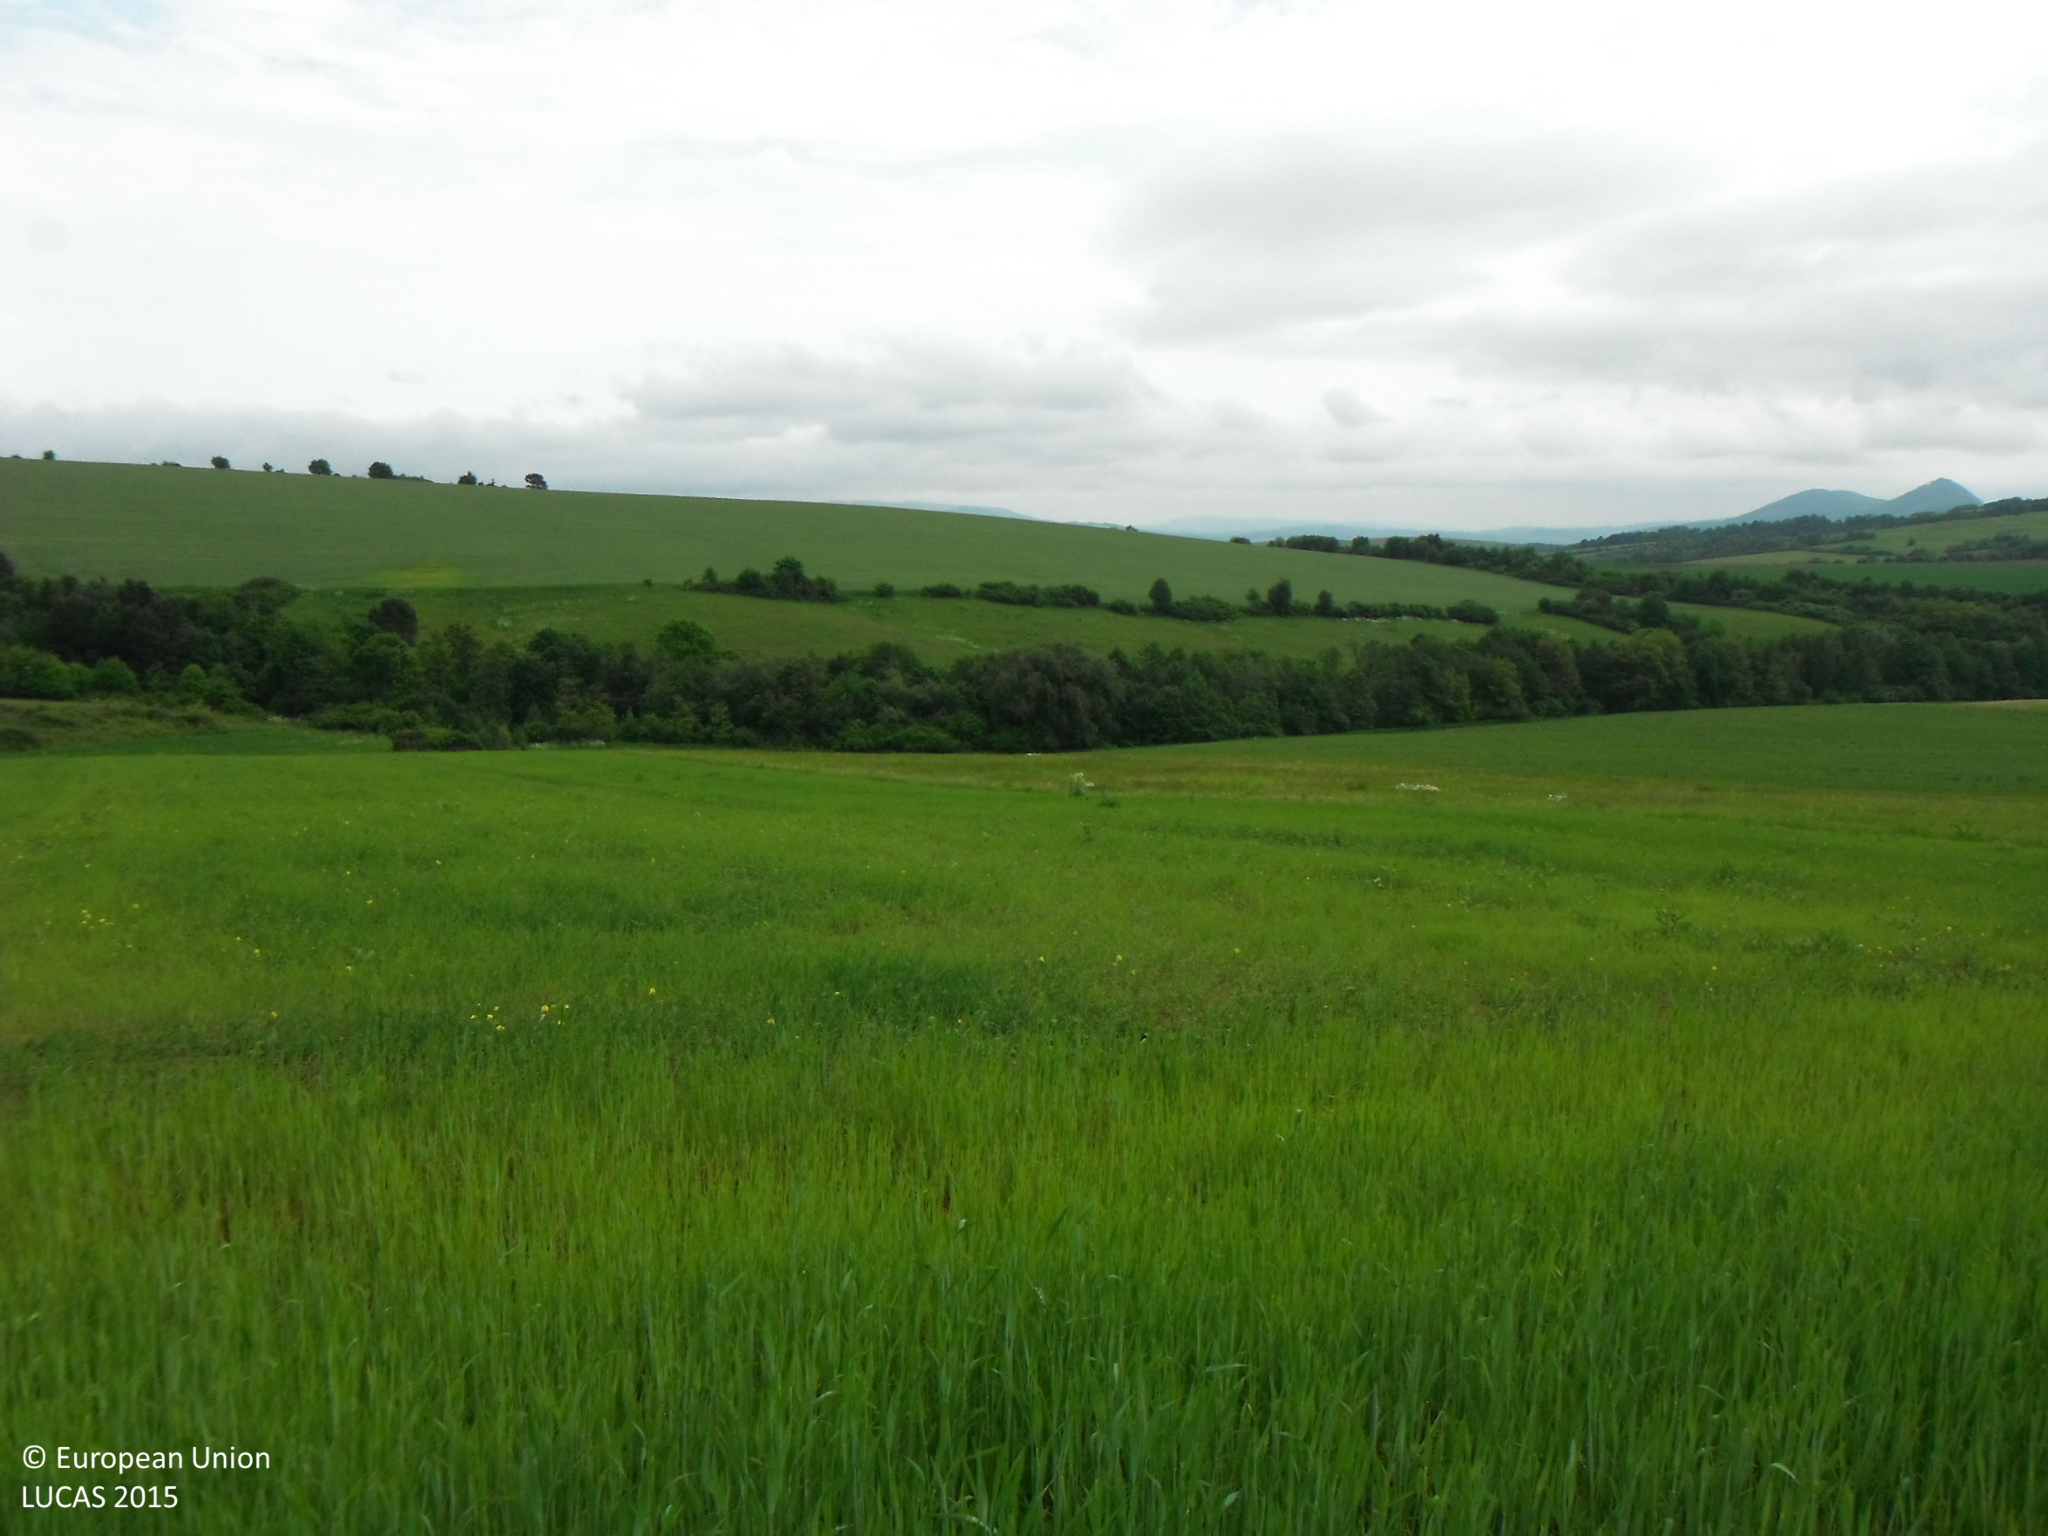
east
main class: Cropland
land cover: Common wheat
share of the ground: > 75 %
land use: Agriculture (excluding fallow land and kitchen gardens)
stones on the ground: < 10 %
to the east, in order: Common wheat; Barley; Temporary grasslands; Spontaneously vegetated surfaces; Shrubland with sparse tree cover; Broadleaved woodland; Rivers and streams
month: May
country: SK
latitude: 49.1030
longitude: 21.2080
